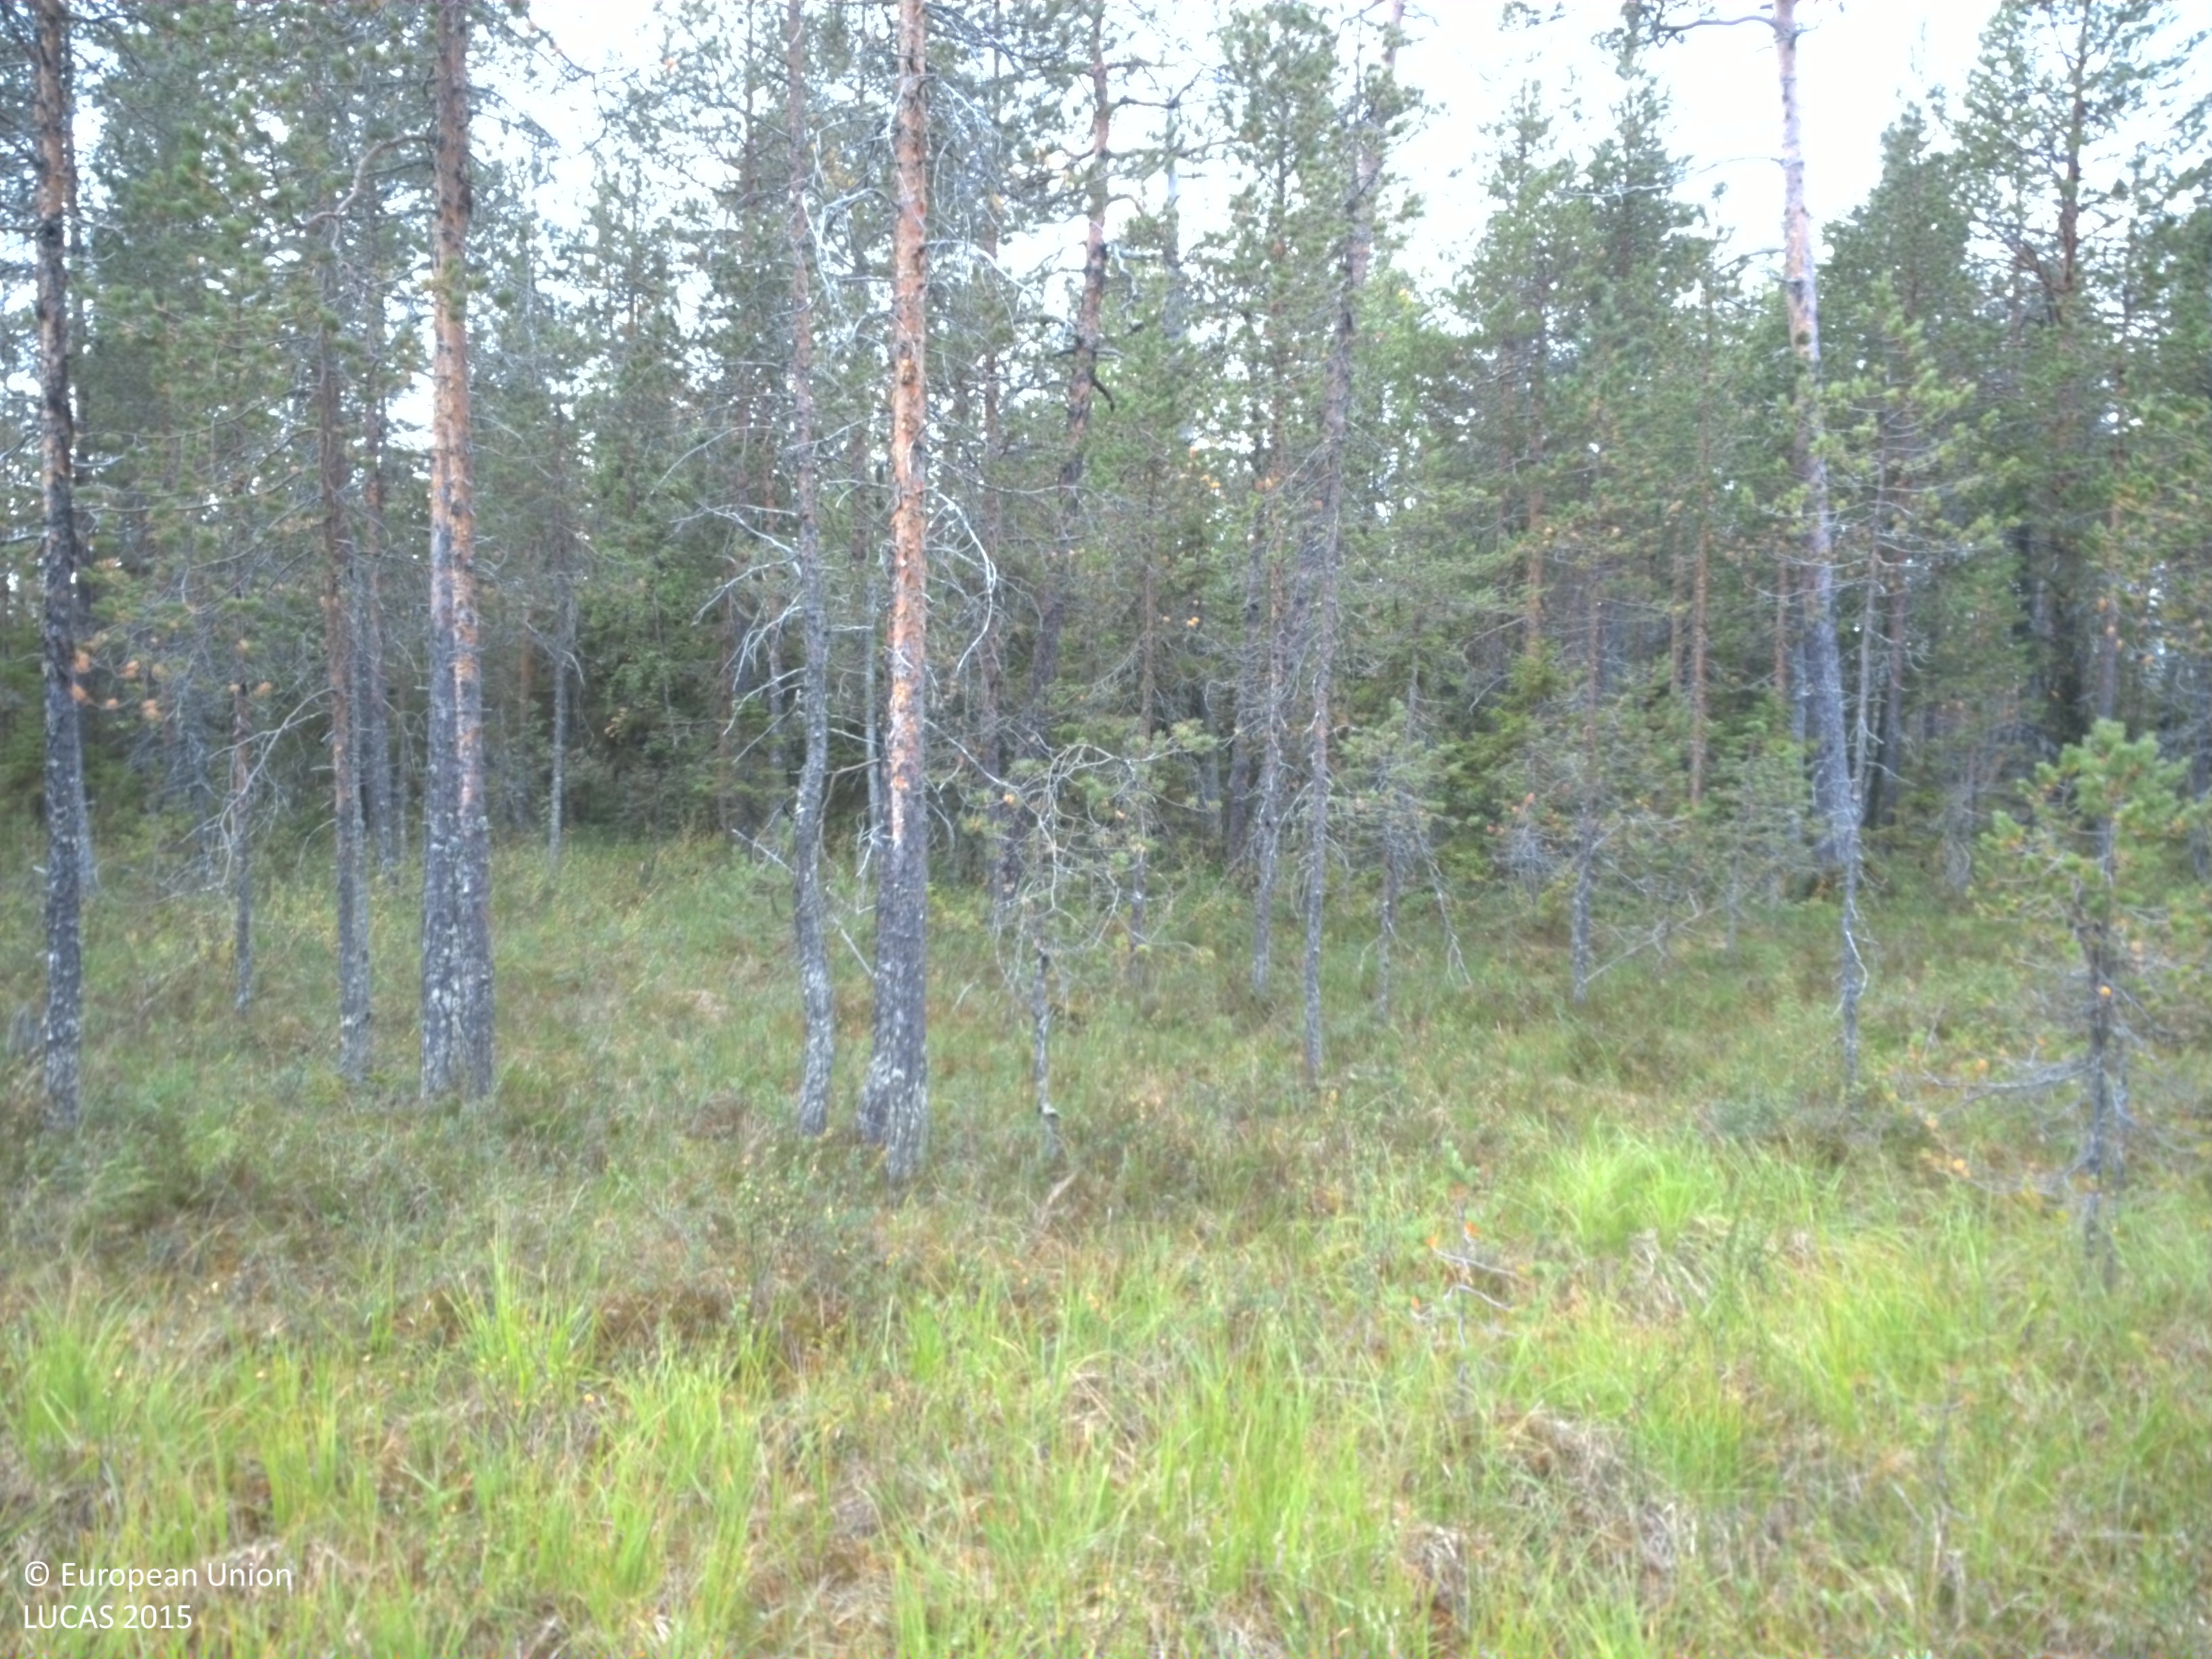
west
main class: Woodland
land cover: Pine dominated coniferous woodland
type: mire and swamp forests
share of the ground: 10 - 25 %
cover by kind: herbaceous plants 45 %, coniferous forest trees 20 %, lichens and mosses 20 %, shrubs 15 %
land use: Semi-natural and natural areas not in use
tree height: > 5 m
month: August
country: SE
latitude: 64.5987
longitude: 16.7574
